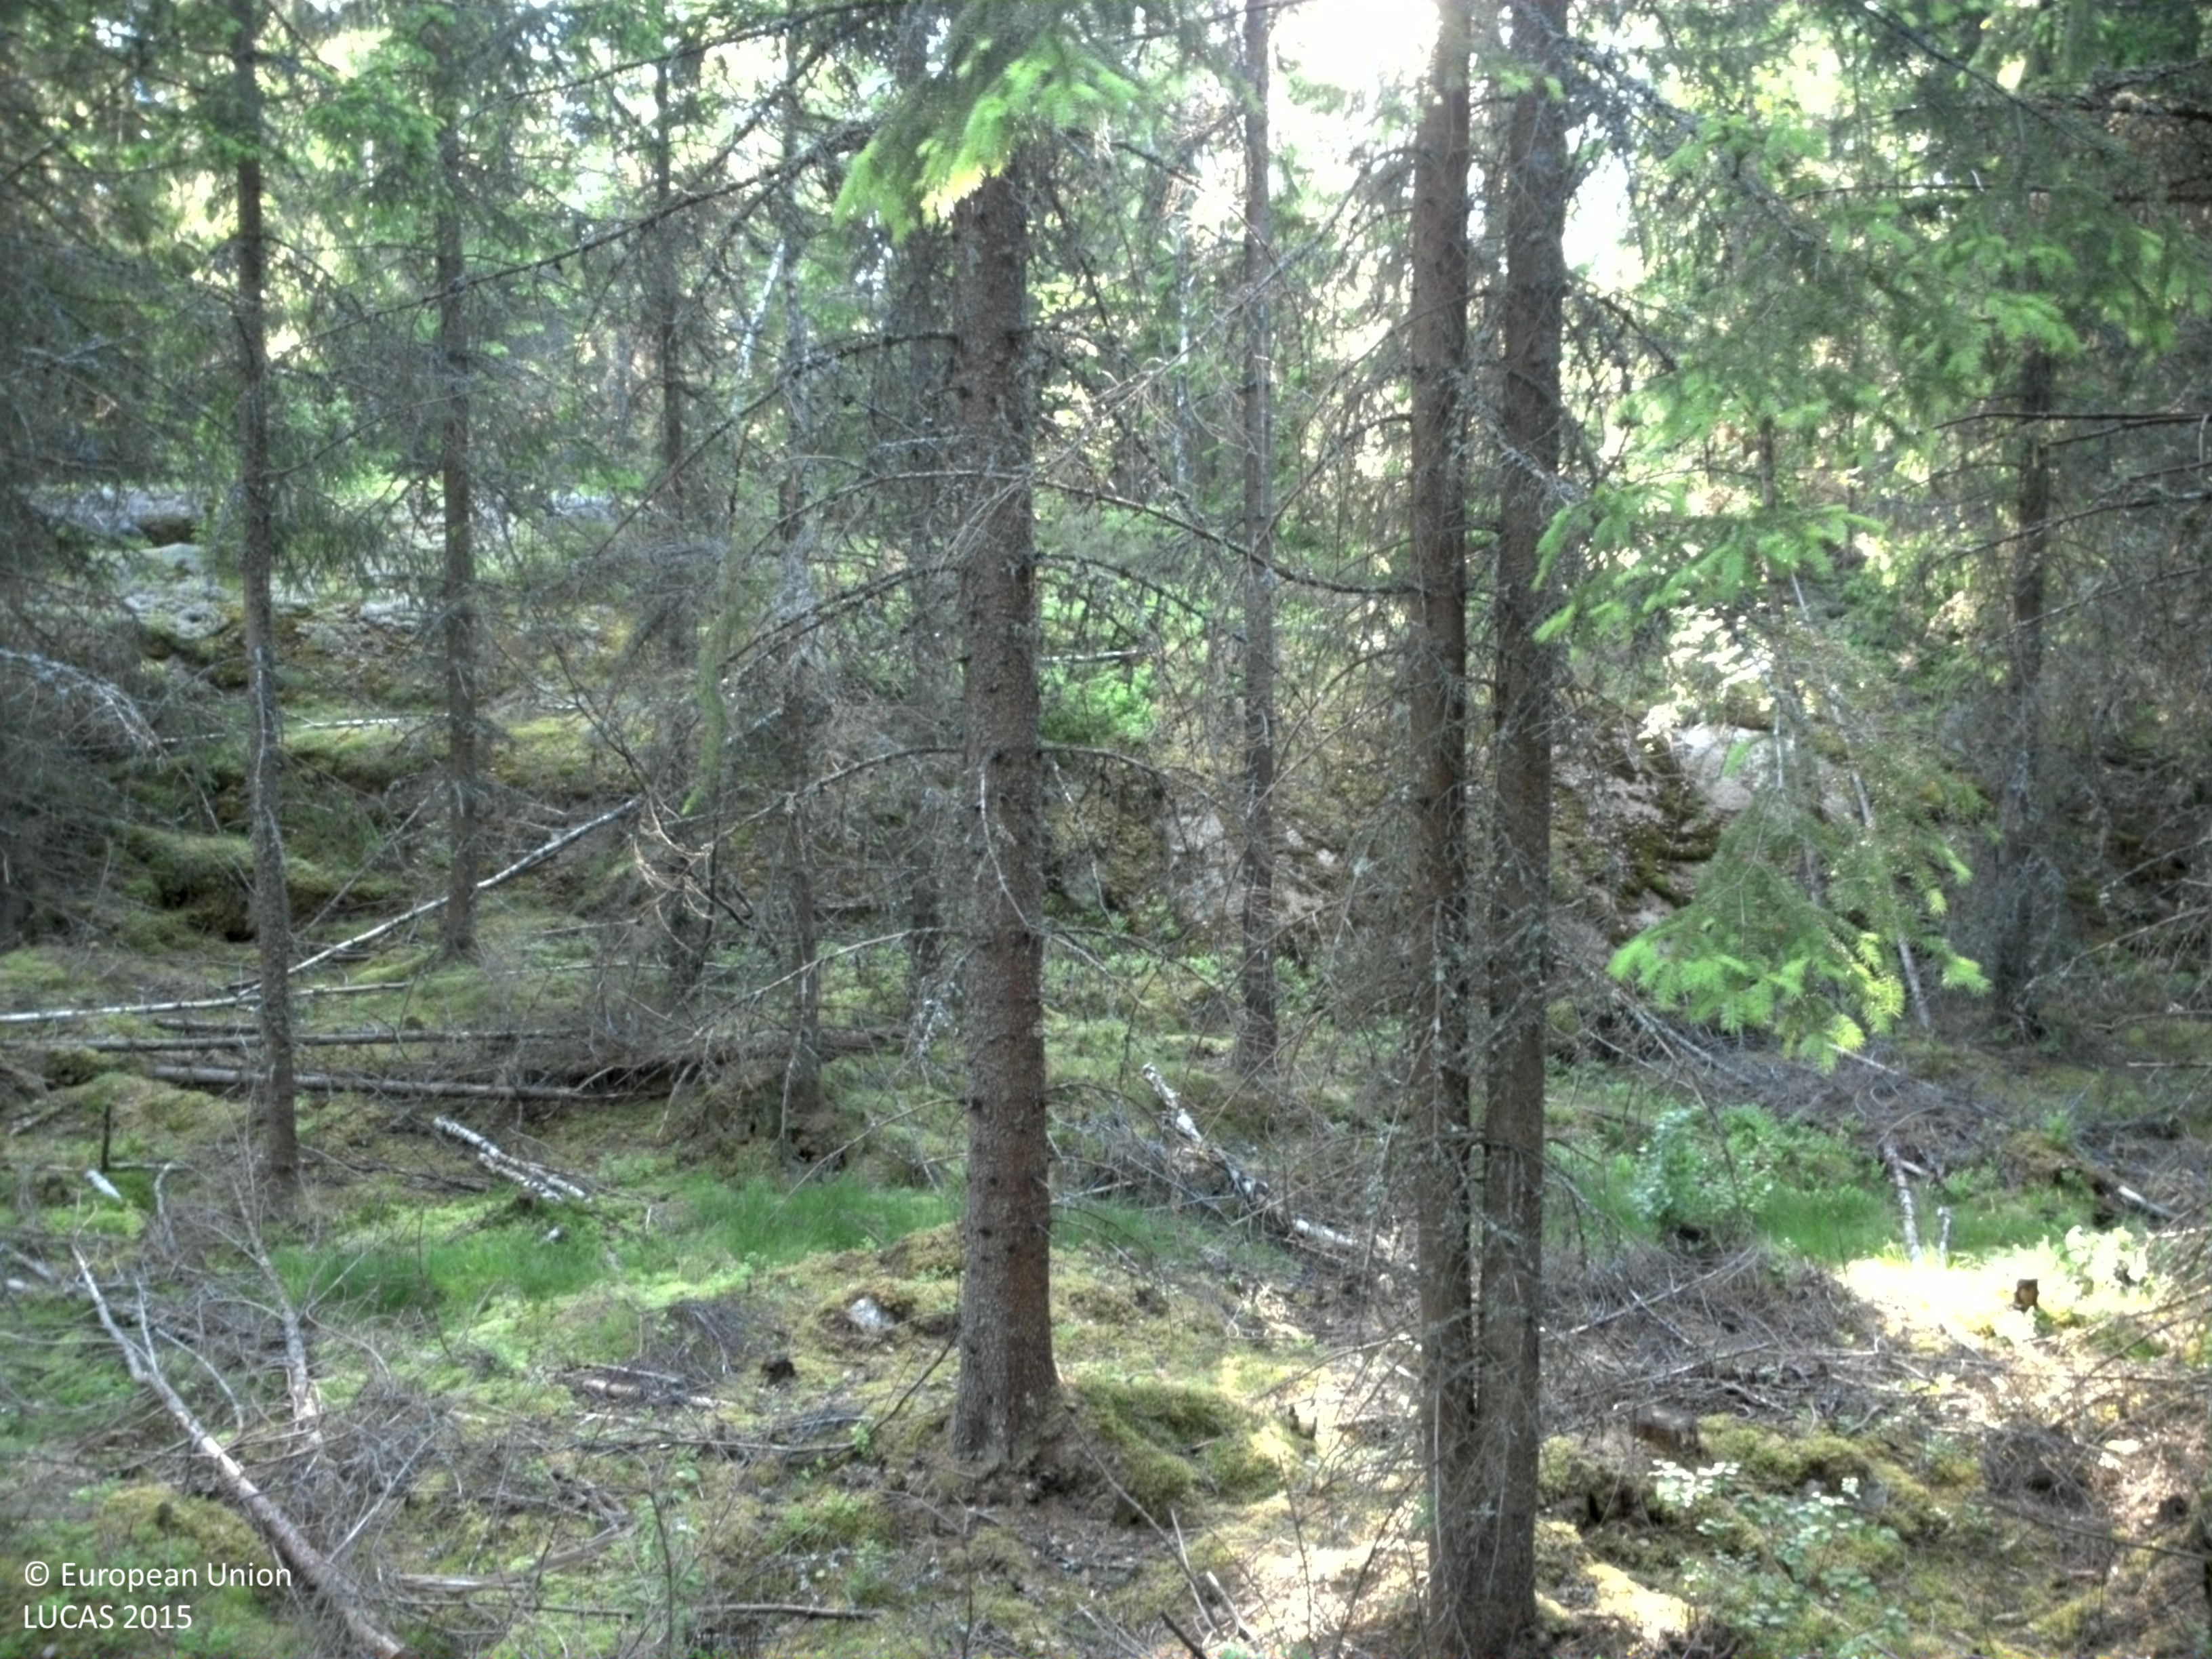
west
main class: Woodland
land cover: Spruce dominated coniferous woodland
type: boreal forest
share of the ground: 50 - 75 %
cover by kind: coniferous forest trees 65 %, lichens and mosses 20 %, broadleaved forest trees 10 %, shrubs 5 %
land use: Forestry
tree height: > 5 m
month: June
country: SE
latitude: 58.6154
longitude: 14.4177
